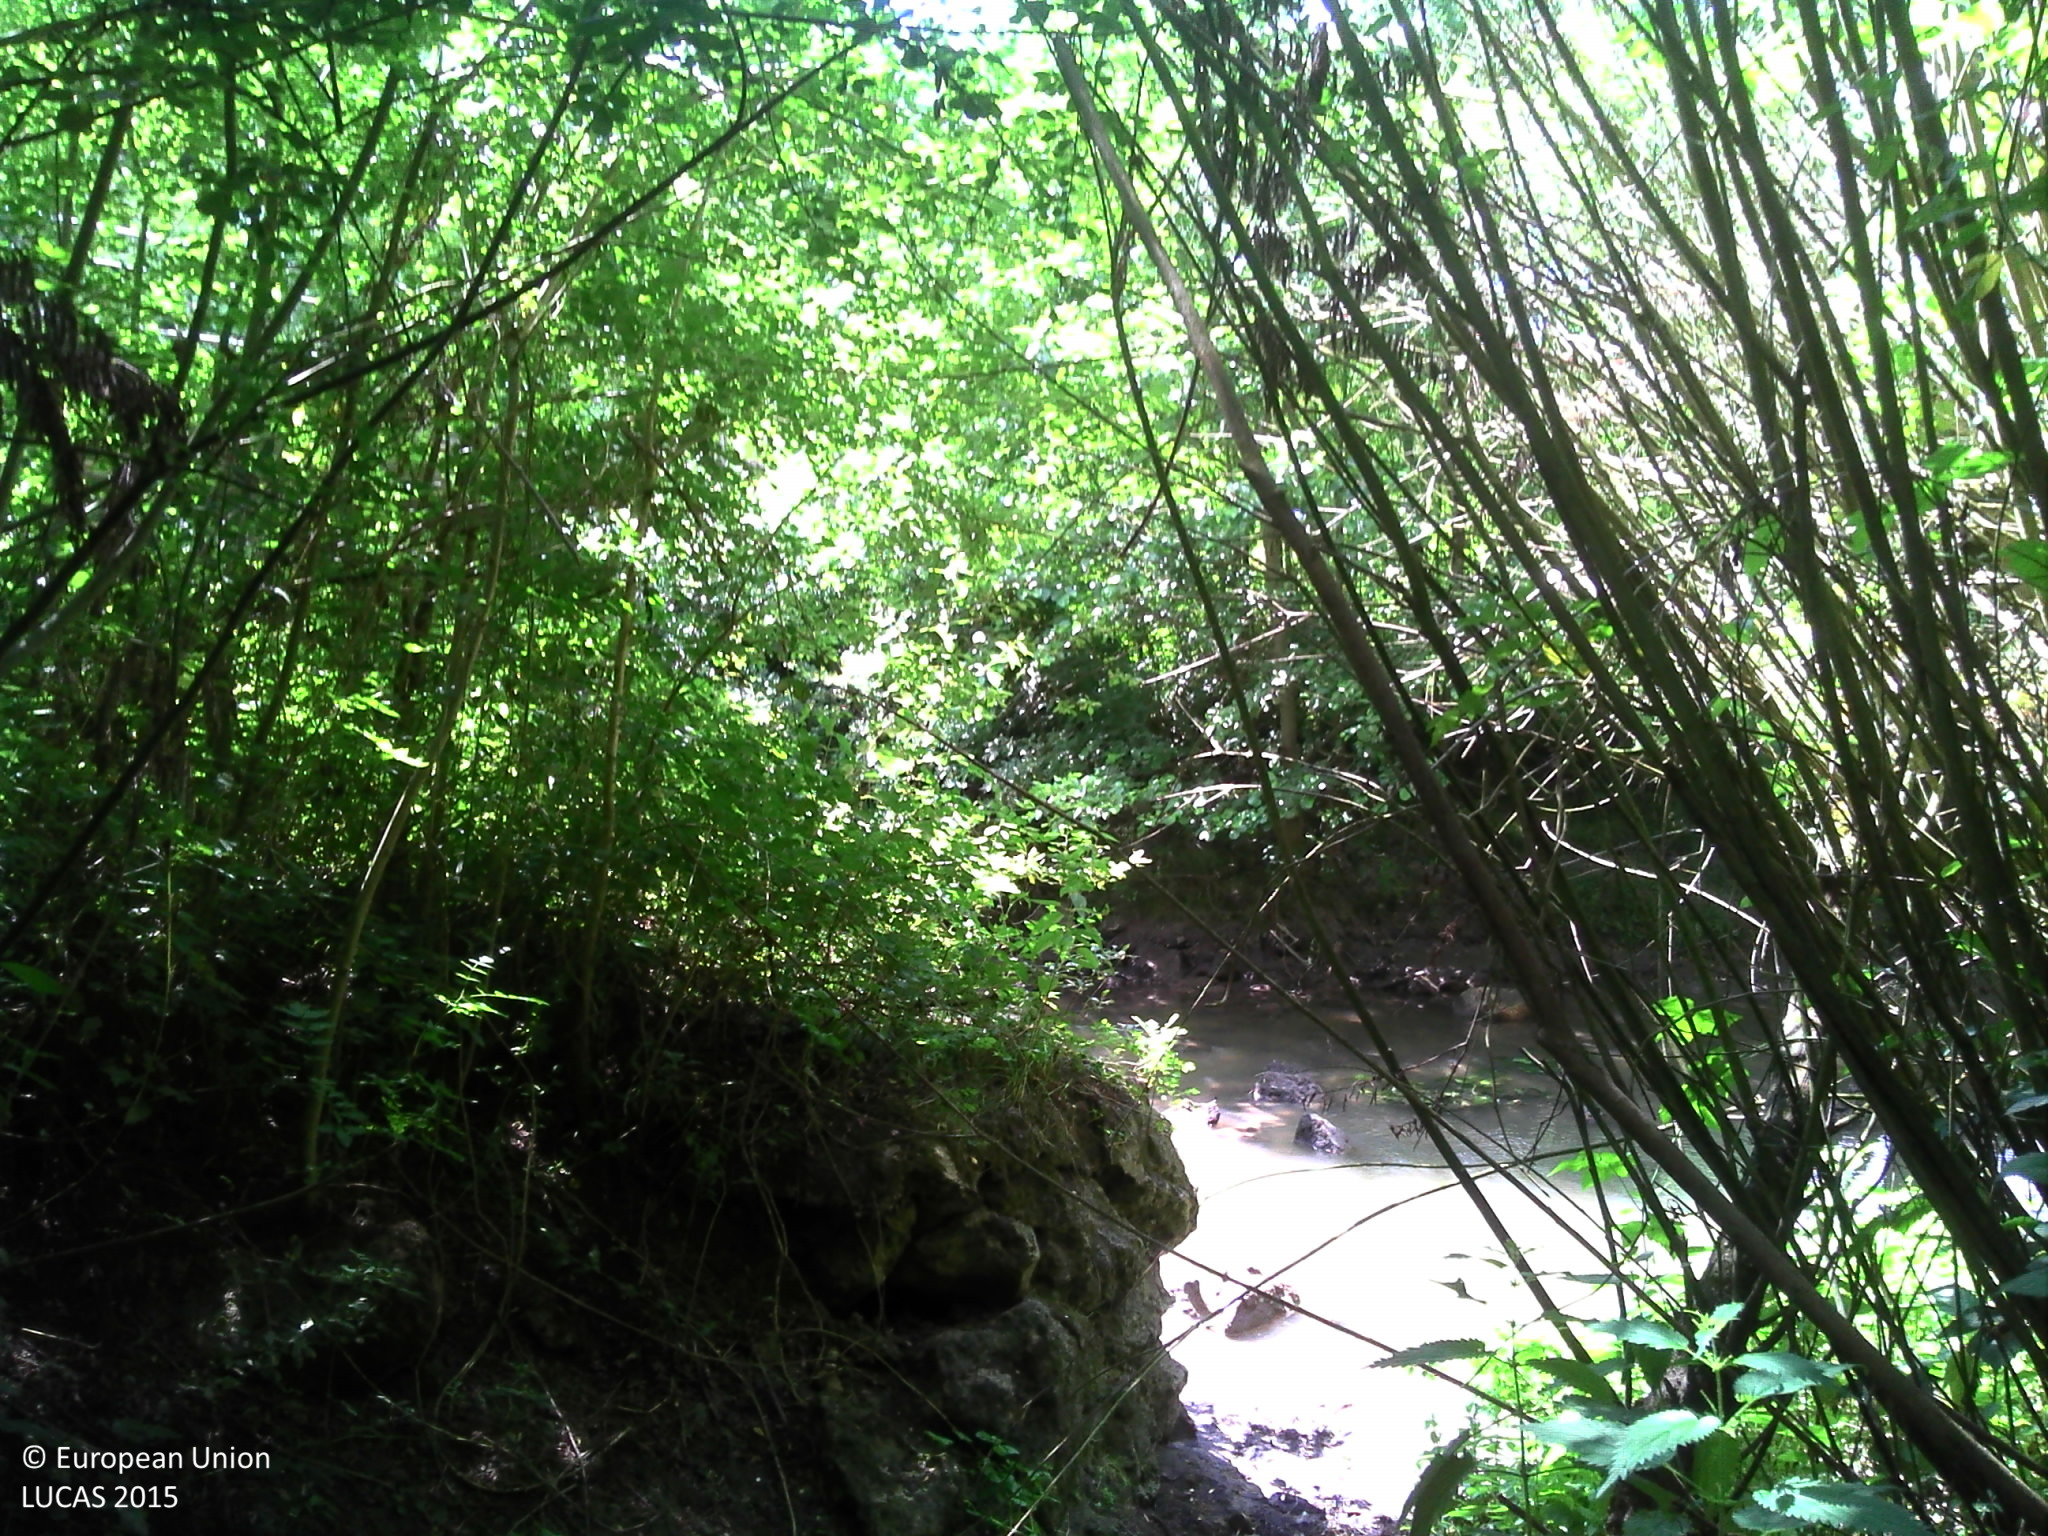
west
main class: Woodland
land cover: Broadleaved woodland
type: floodplain forest
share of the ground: > 75 %
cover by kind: broadleaved forest trees 75 %, herbaceous plants 15 %, shrubs 5 %, lichens and mosses 5 %
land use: Forestry
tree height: > 5 m
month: June
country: FR
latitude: 47.2762
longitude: 0.7944
